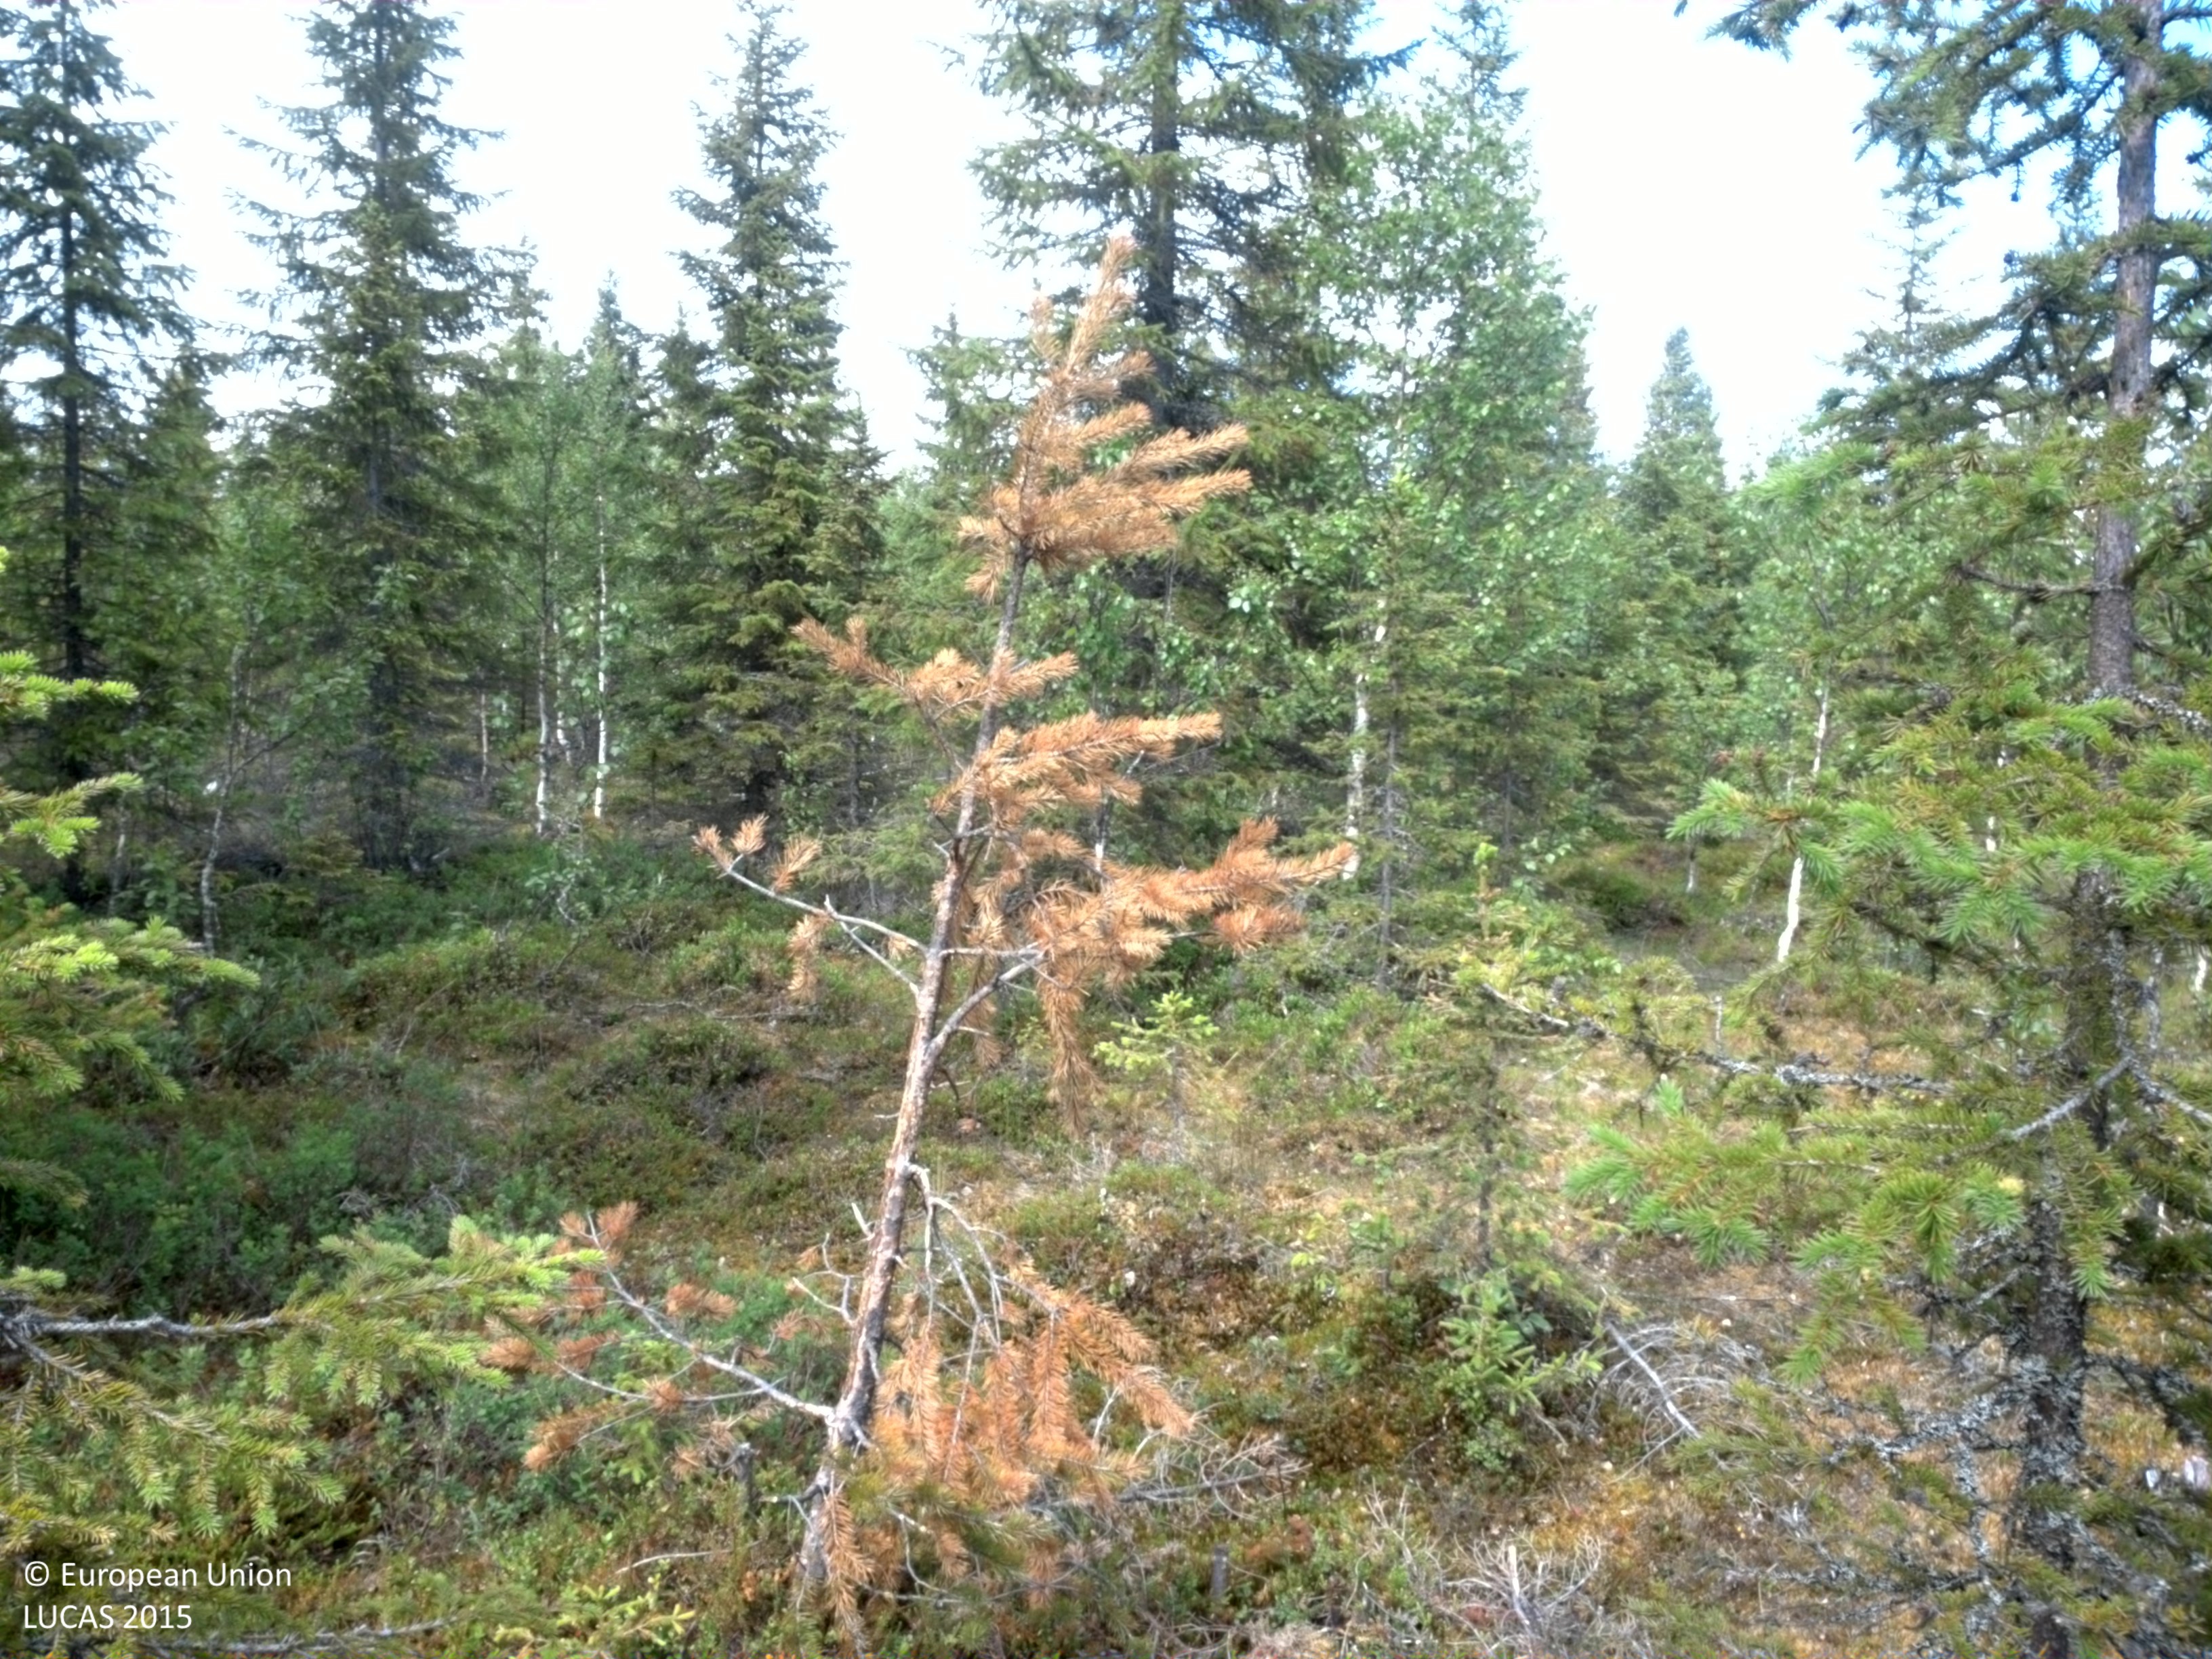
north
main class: Woodland
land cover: Spruce dominated mixed woodland
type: boreal forest
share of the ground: 25 - 50 %
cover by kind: coniferous forest trees 30 %, shrubs 25 %, lichens and mosses 25 %, broadleaved forest trees 10 %, herbaceous plants 10 %
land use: Forestry
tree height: < 5 m
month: July
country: SE
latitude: 64.4912
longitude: 18.2719
